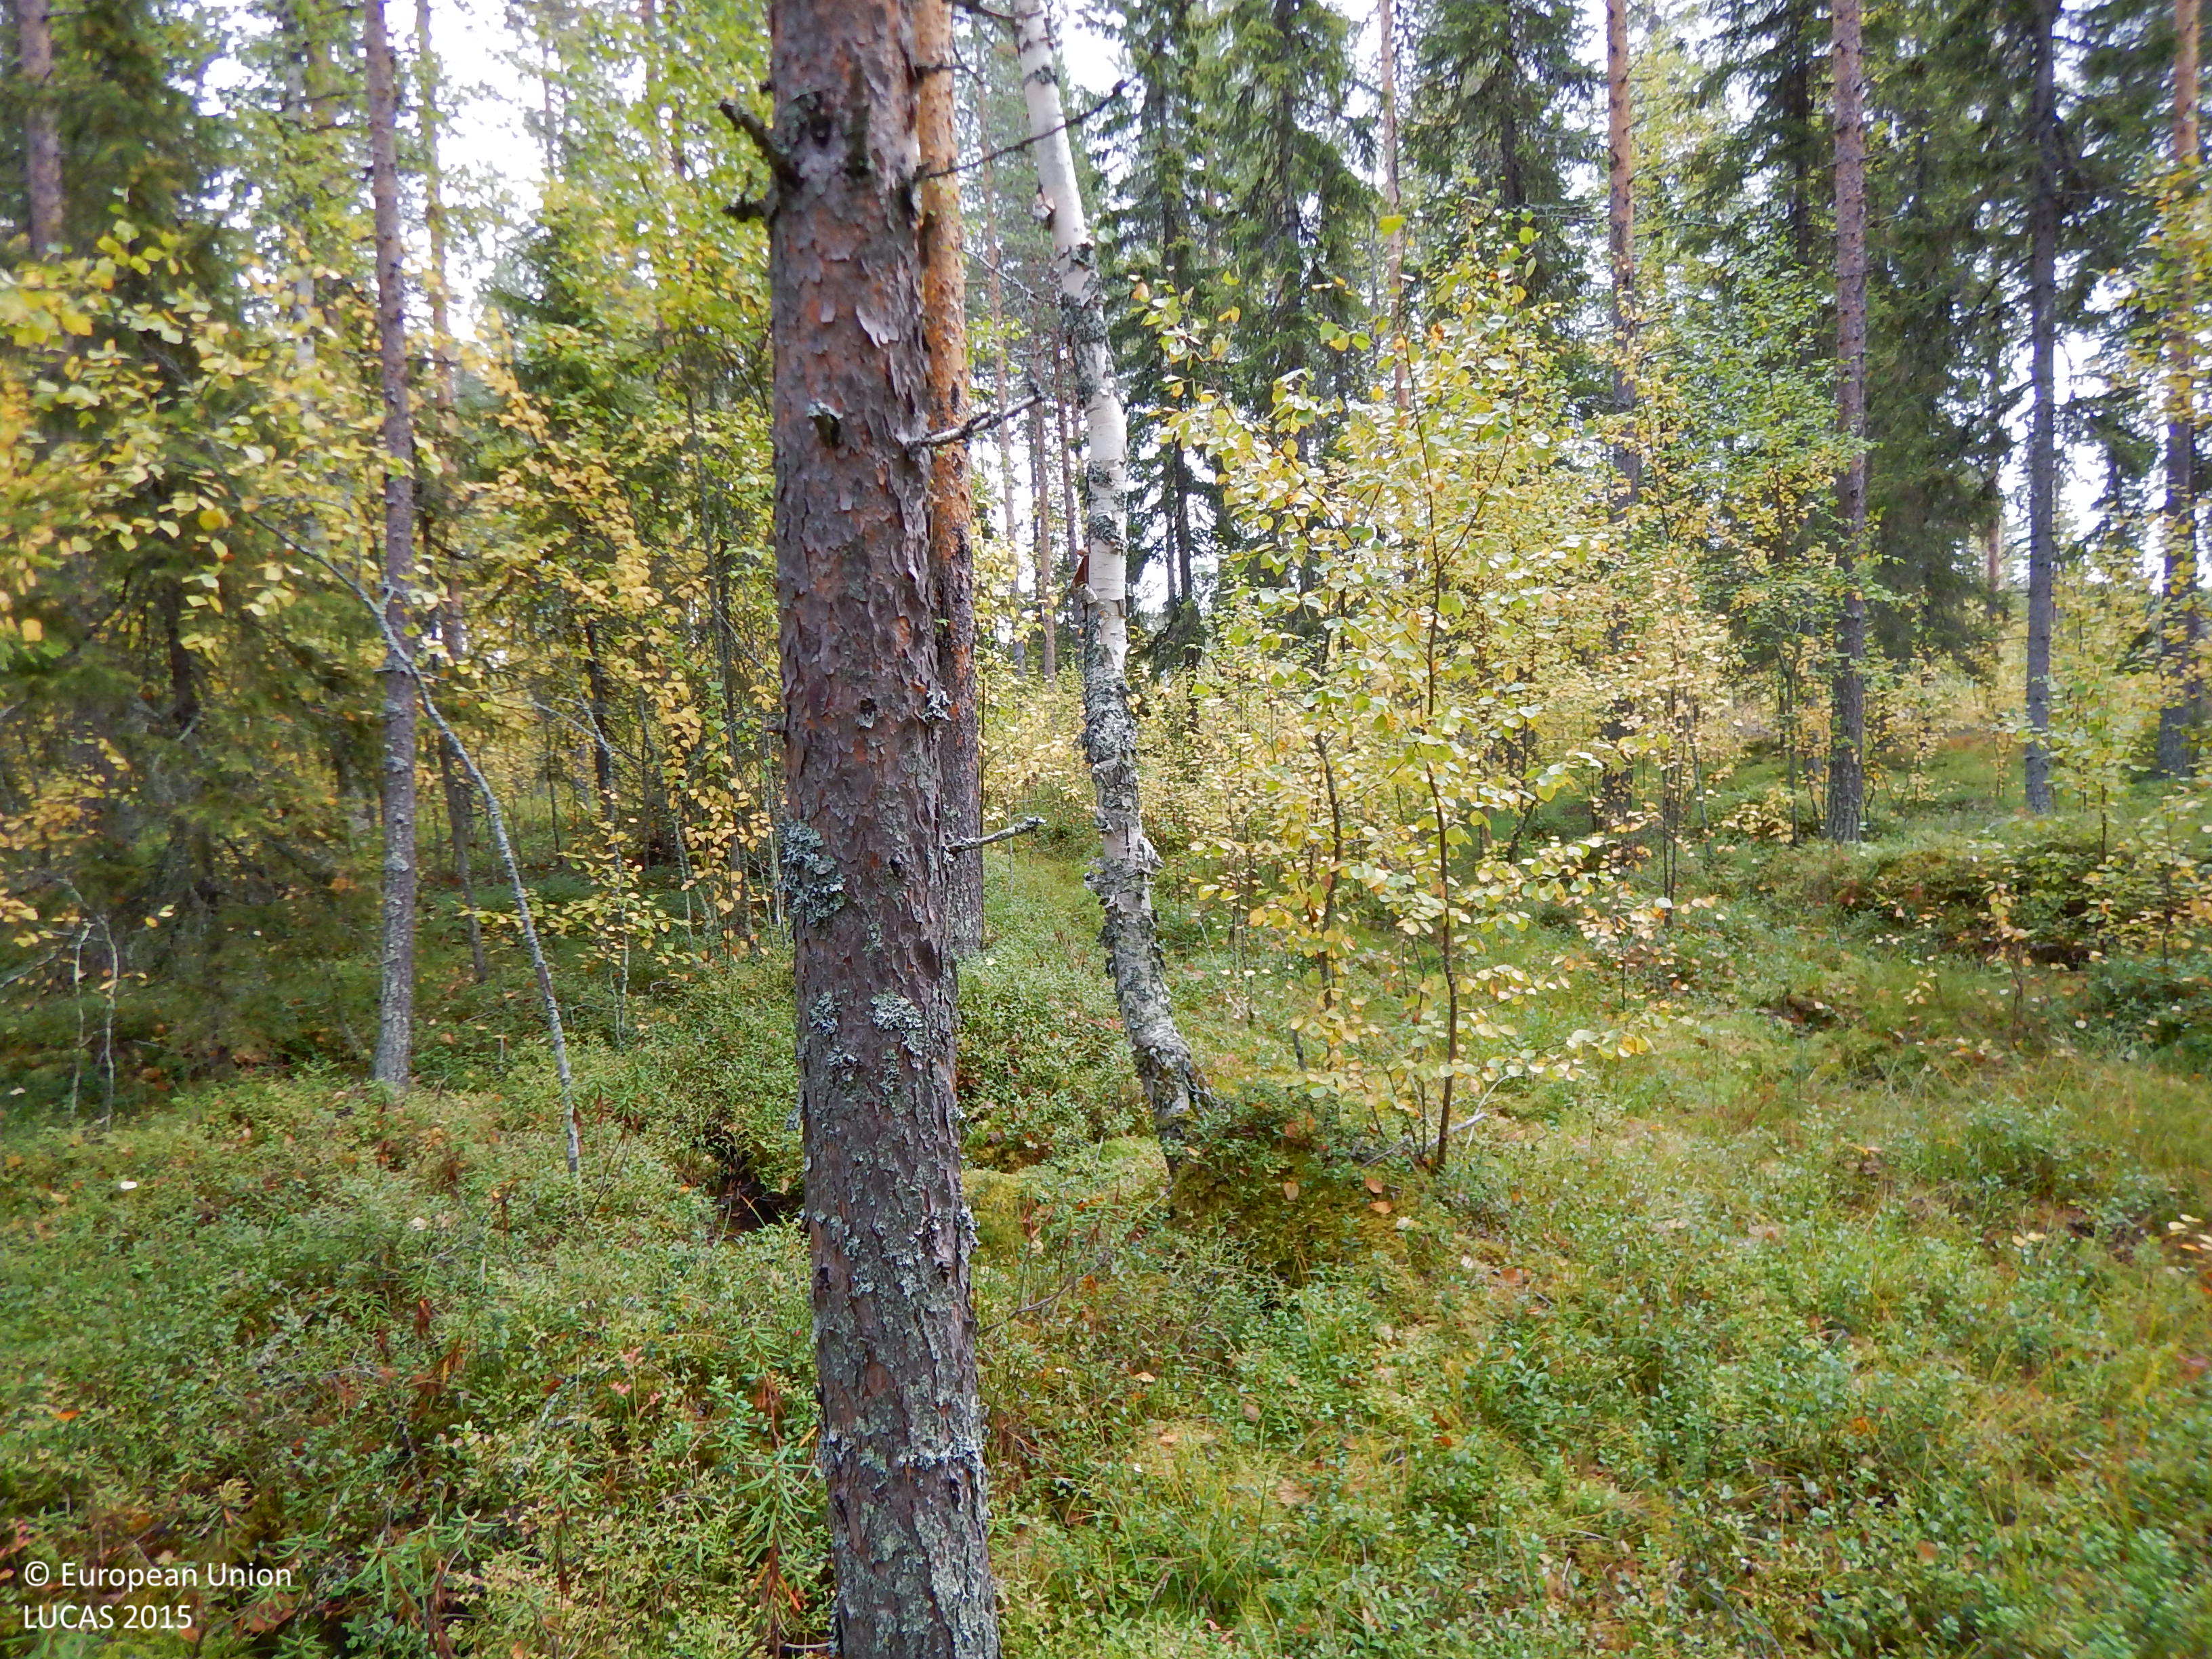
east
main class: Woodland
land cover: Pine dominated mixed woodland
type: boreal forest
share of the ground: 50 - 75 %
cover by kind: coniferous forest trees 40 %, shrubs 20 %, broadleaved forest trees 15 %, lichens and mosses 15 %, herbaceous plants 10 %
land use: Forestry
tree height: > 5 m
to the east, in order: Pine dominated mixed woodland; Tracks; Other coniferous woodland; Shruby margins; Other bare soil; Ditches and canals; Paved roads, cycling and walking lanes; Ditches and canals; Other bare soil; Other mixed woodland; Broadleaved woodland
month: September
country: SE
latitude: 64.8384
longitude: 19.8564
